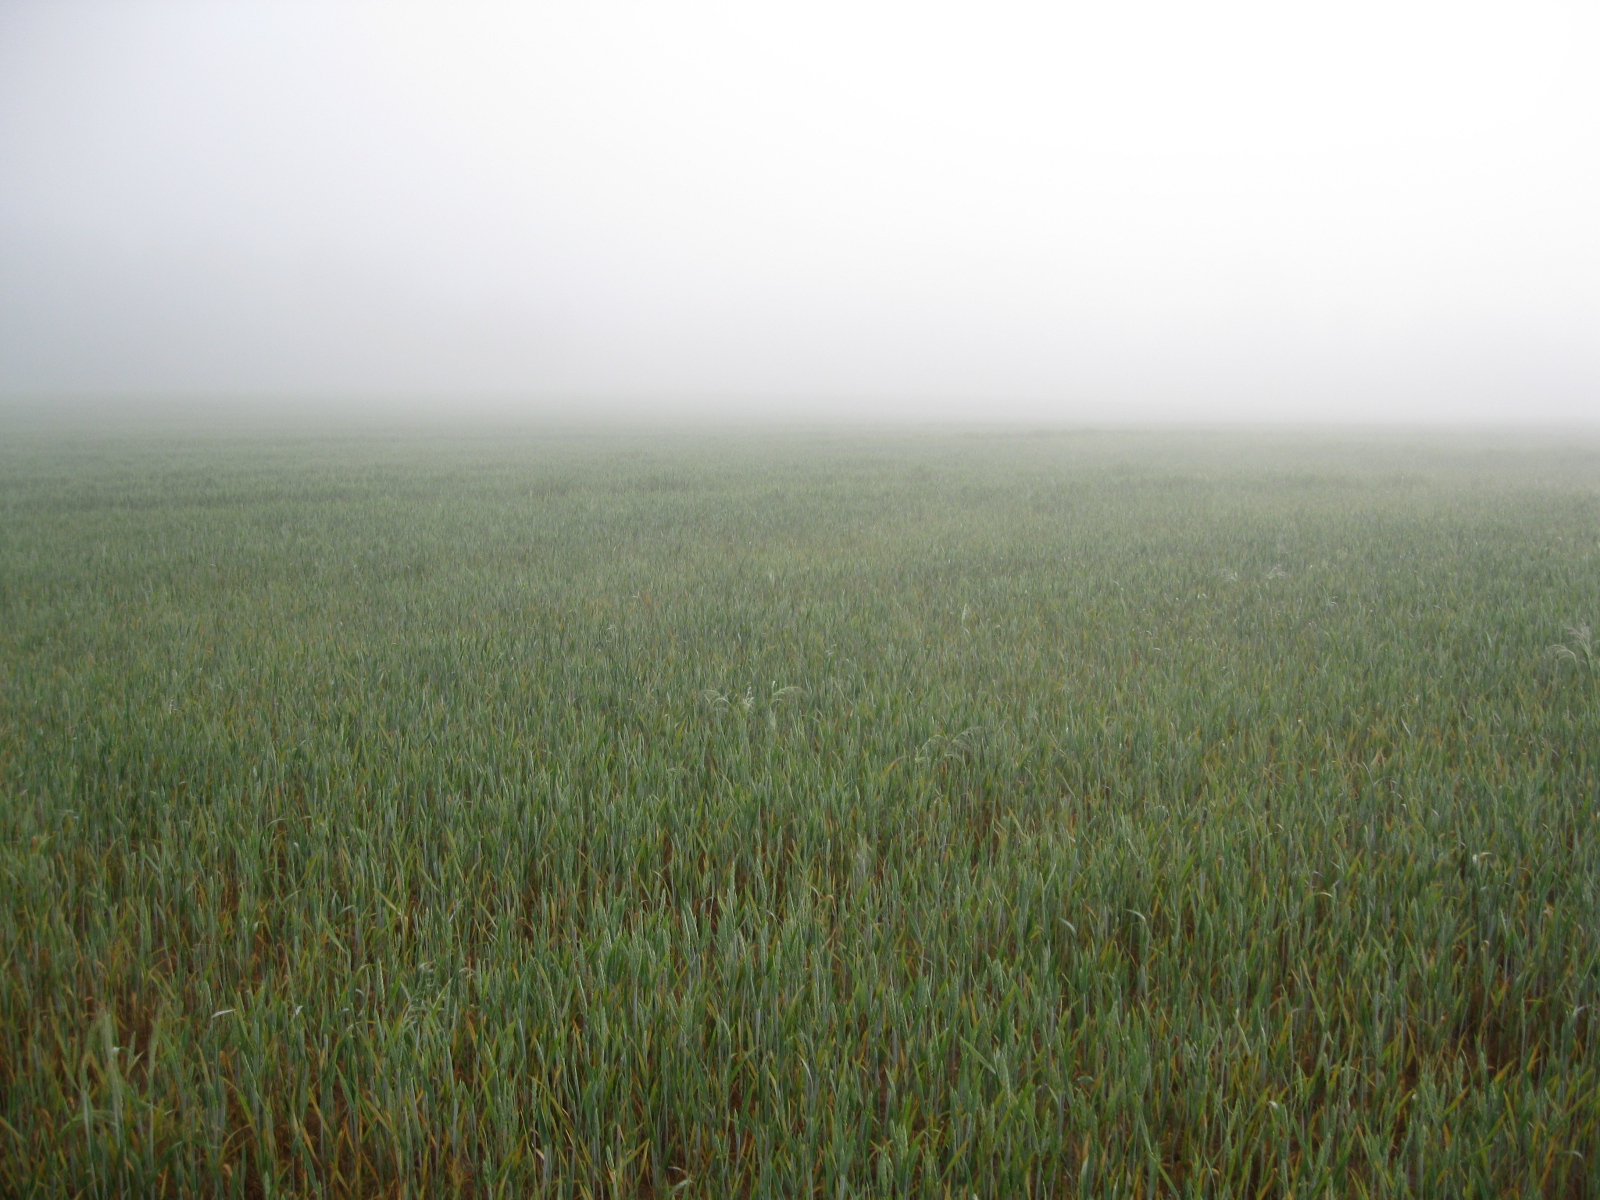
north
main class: Cropland
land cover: Common wheat
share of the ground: > 75 %
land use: Agriculture (excluding fallow land and kitchen gardens)
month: June
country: LT
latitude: 55.4353
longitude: 23.9814
